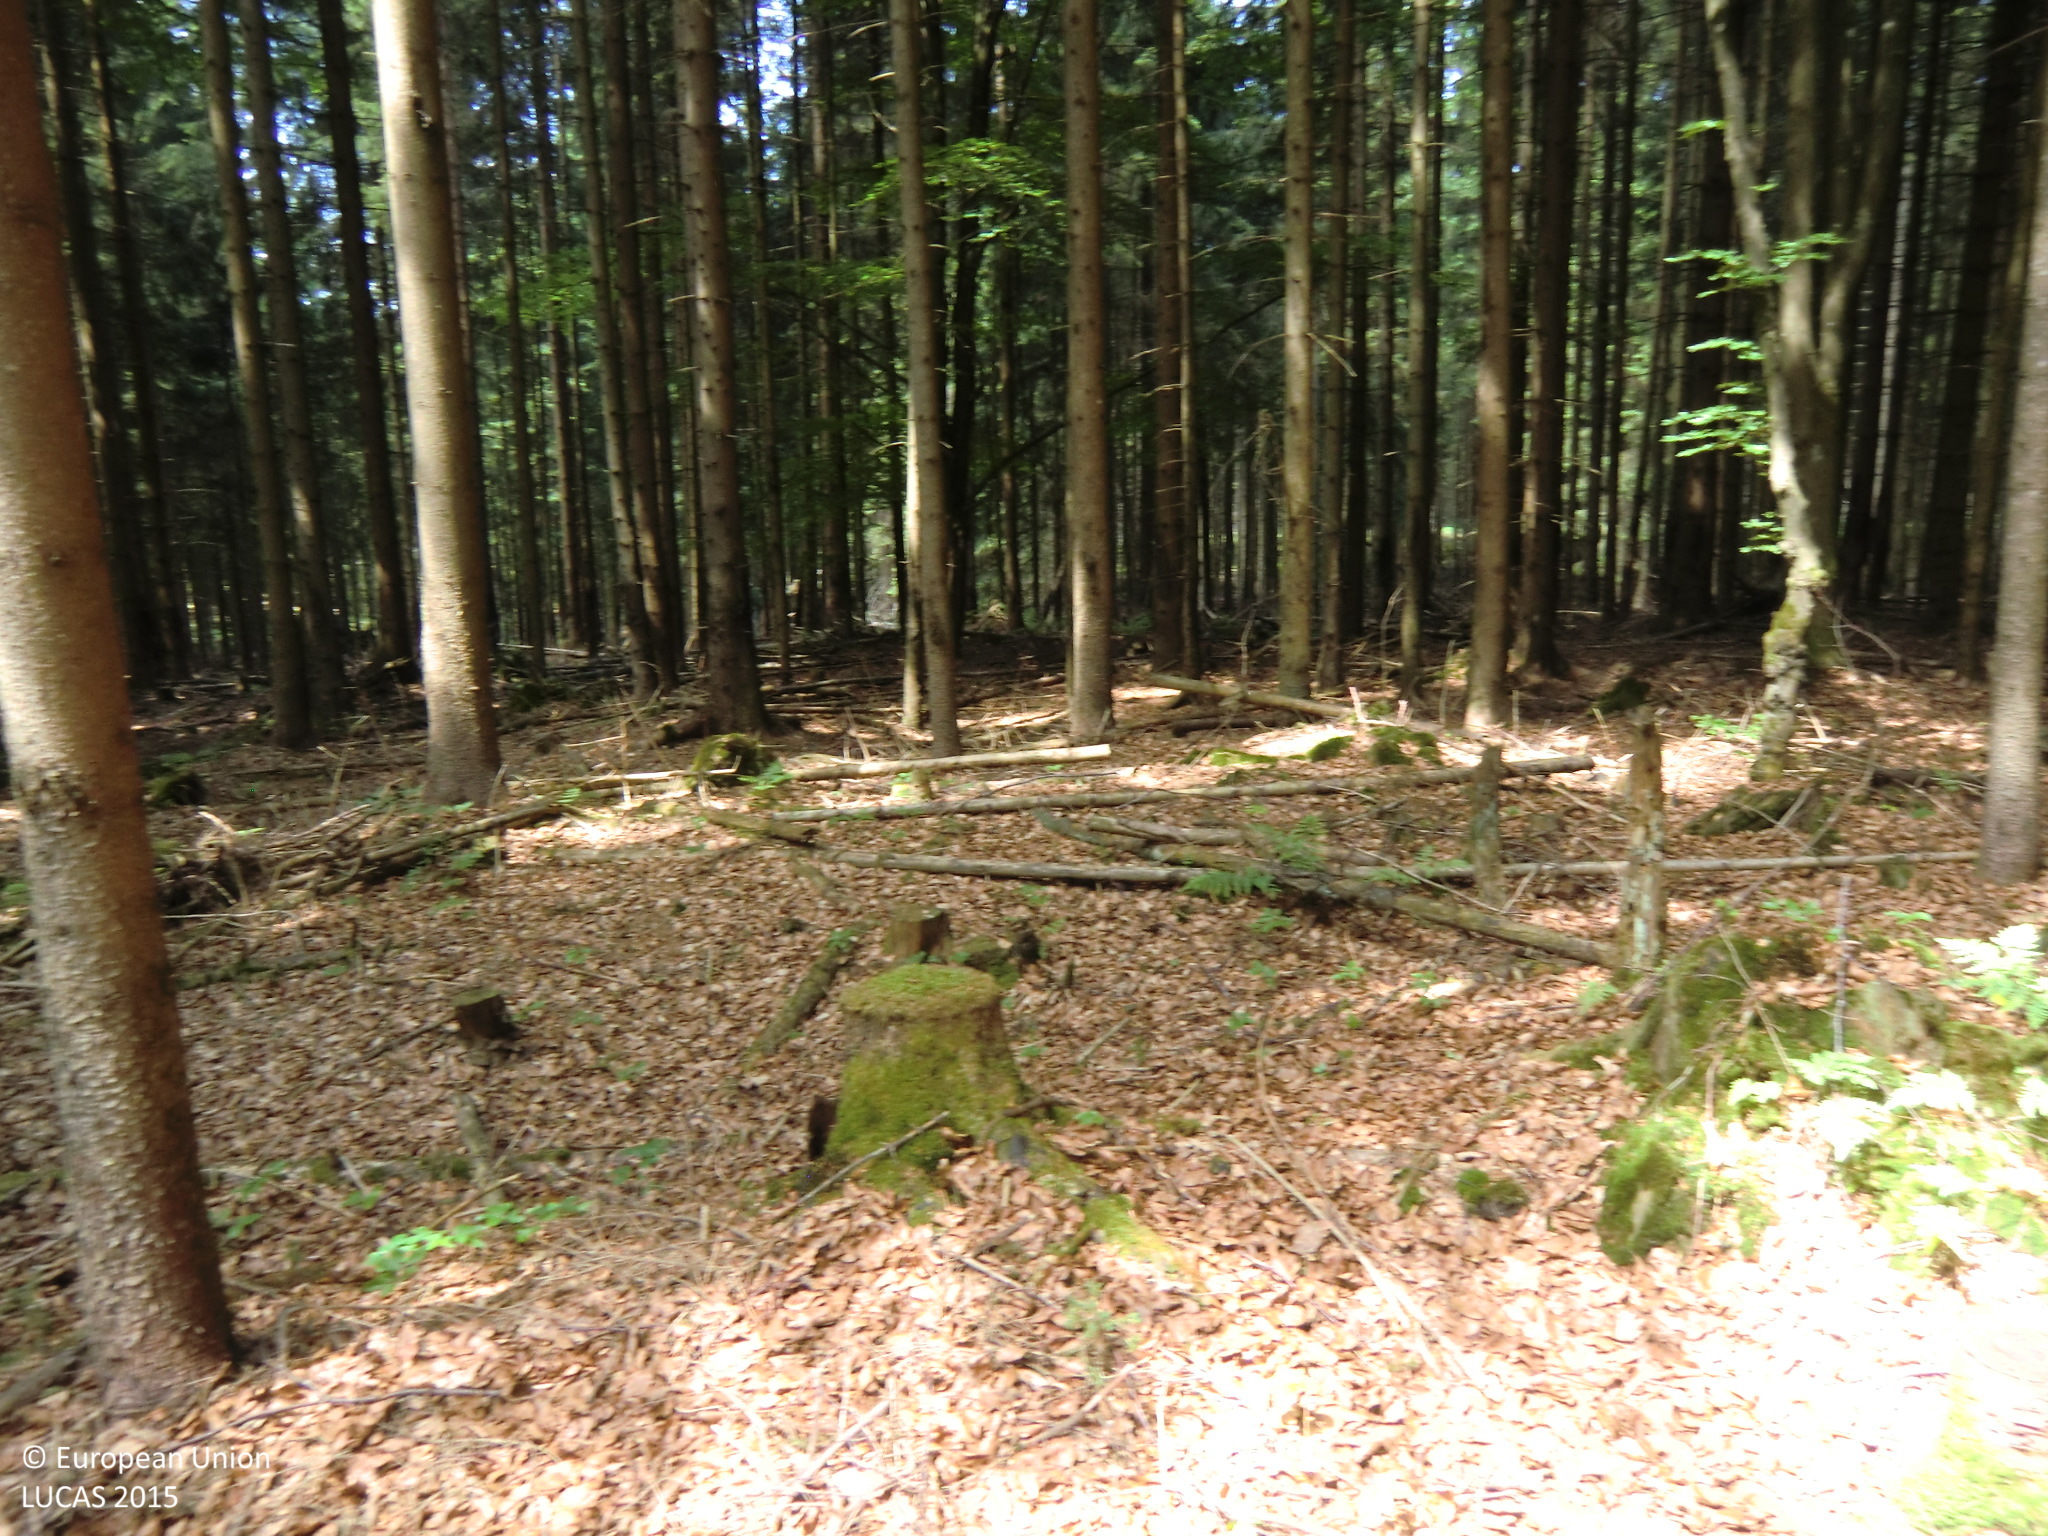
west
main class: Woodland
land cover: Spruce dominated mixed woodland
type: hemiboreal forest and nemoral coniferous forest and mixed broadleaved-coniferous forest
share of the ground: > 75 %
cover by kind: coniferous forest trees 45 %, broadleaved forest trees 45 %, consolidated bare surface 10 %
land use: Forestry
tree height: > 5 m
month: June
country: AT
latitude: 48.3633
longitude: 14.9819
